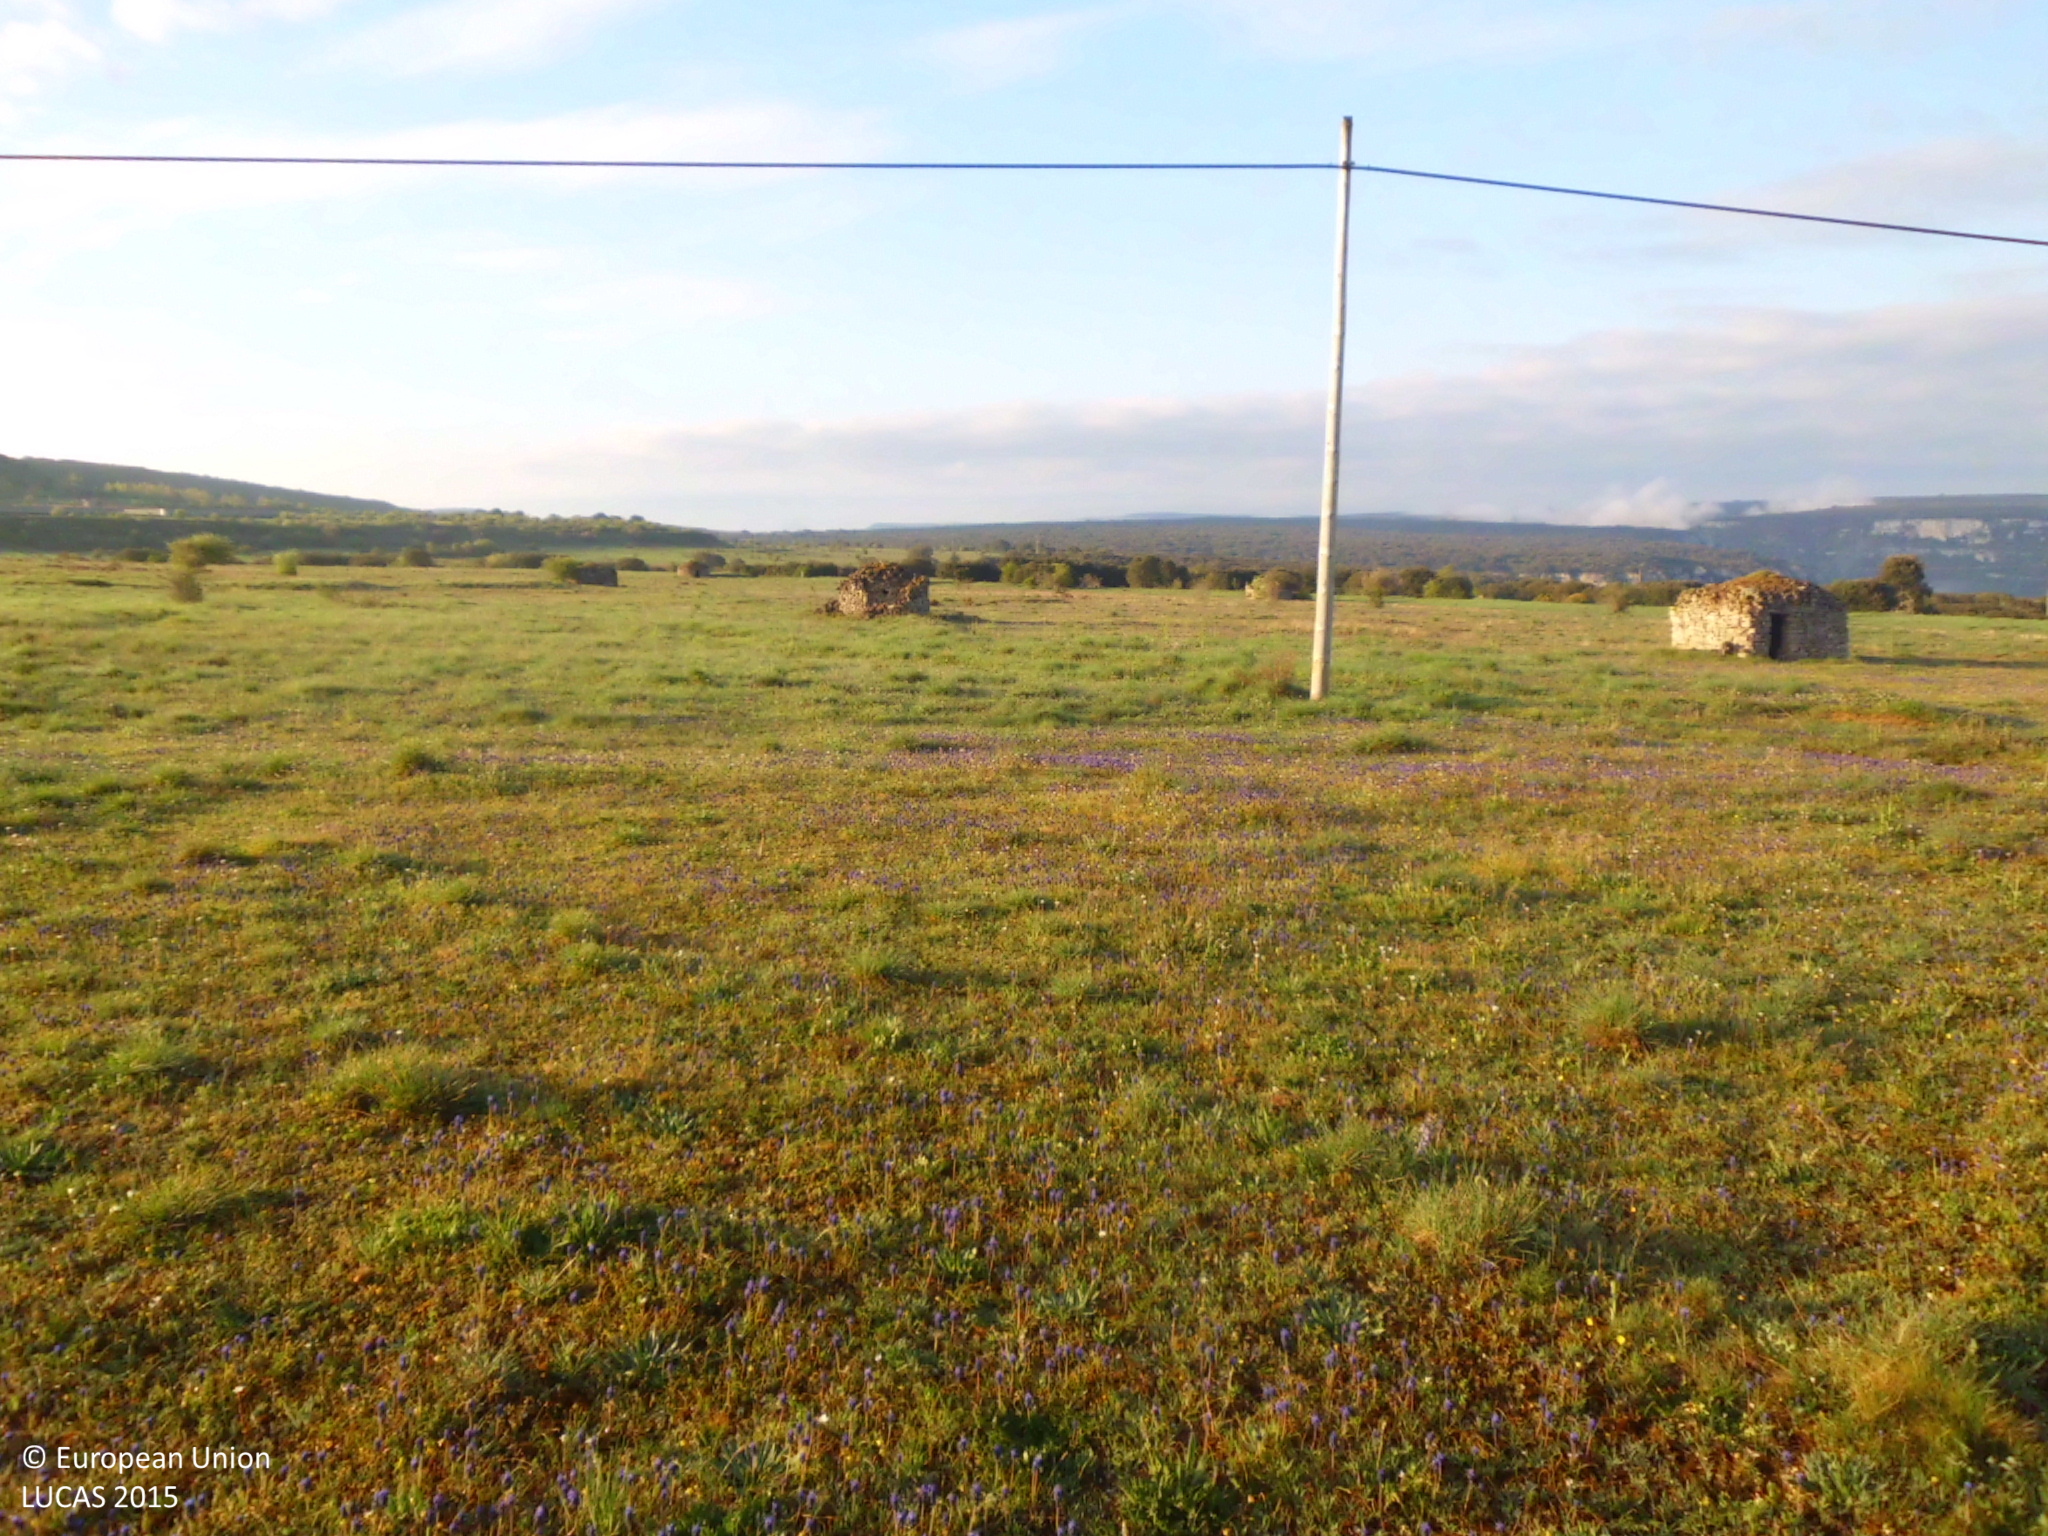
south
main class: Grassland
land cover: Grassland without tree/shrub cover
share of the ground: > 75 %
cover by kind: herbaceous plants 95 %, shrubs 5 %
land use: Abandoned areas
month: April
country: ES
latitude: 42.8407
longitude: -3.7828
